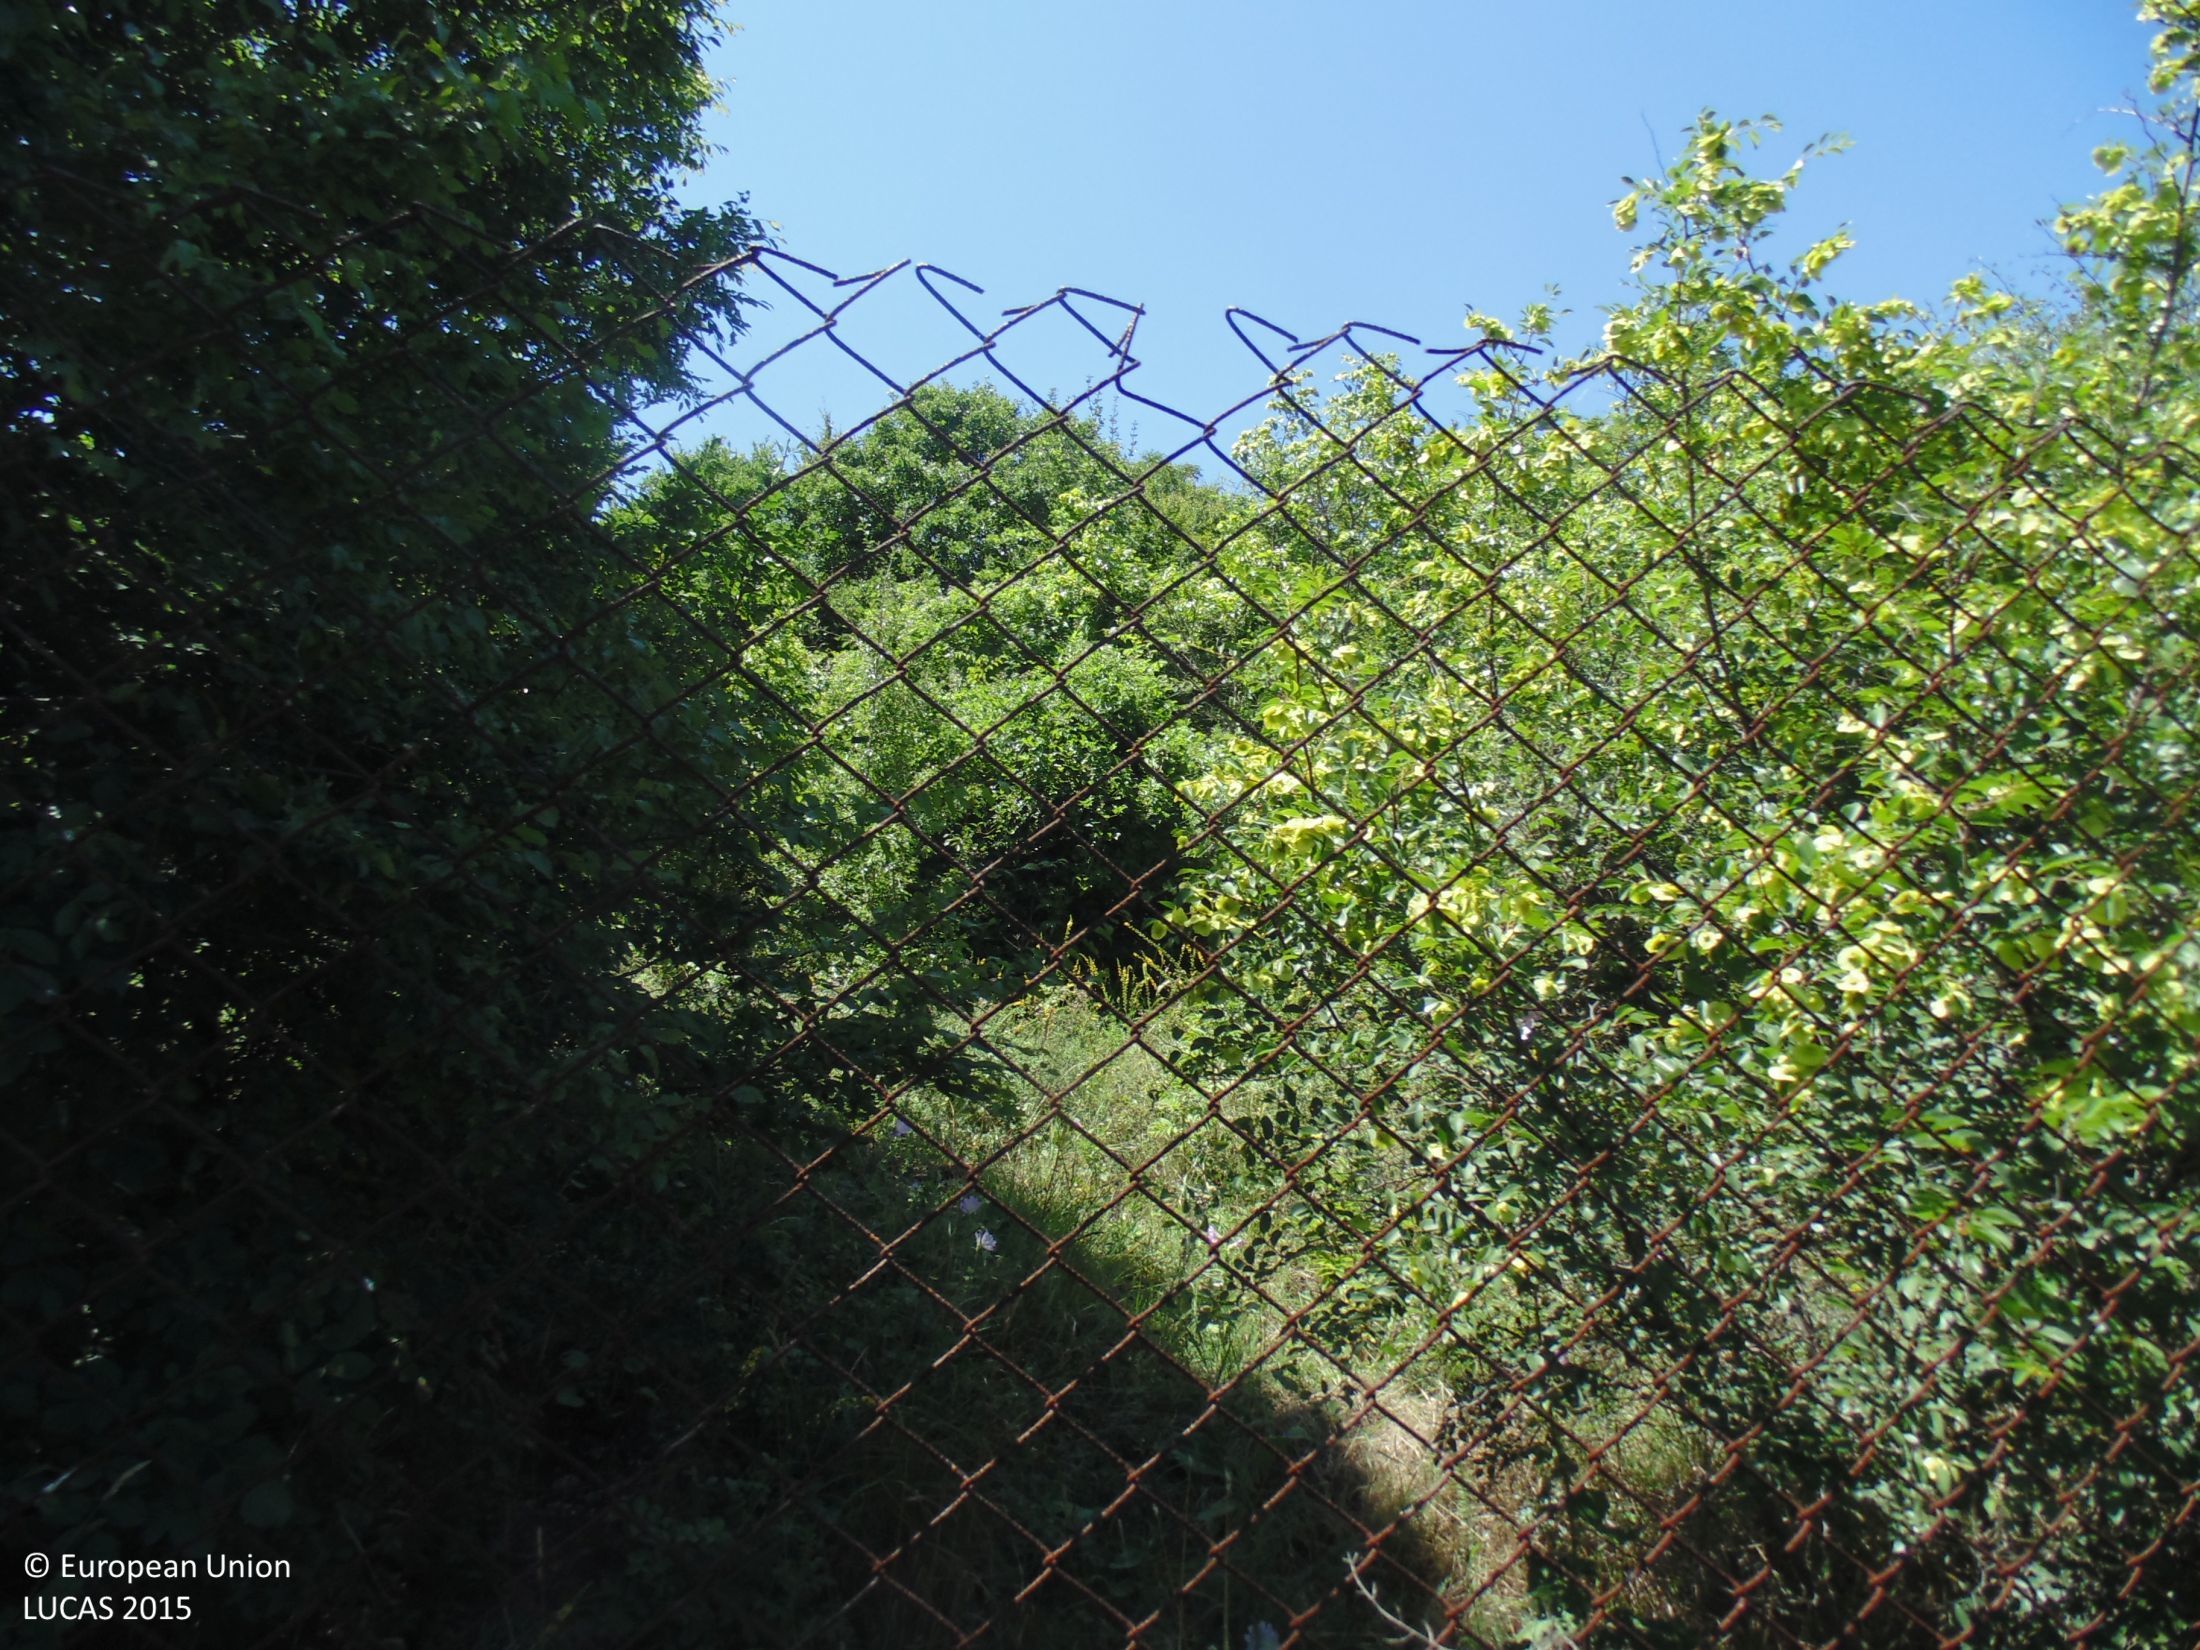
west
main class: Grassland
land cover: Grassland with sparse tree/shrub cover
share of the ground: > 75 %
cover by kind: herbaceous plants 90 %, broadleaved forest trees 5 %, shrubs 5 %
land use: Semi-natural and natural areas not in use
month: July
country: BG
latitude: 43.4171
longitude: 28.0417
